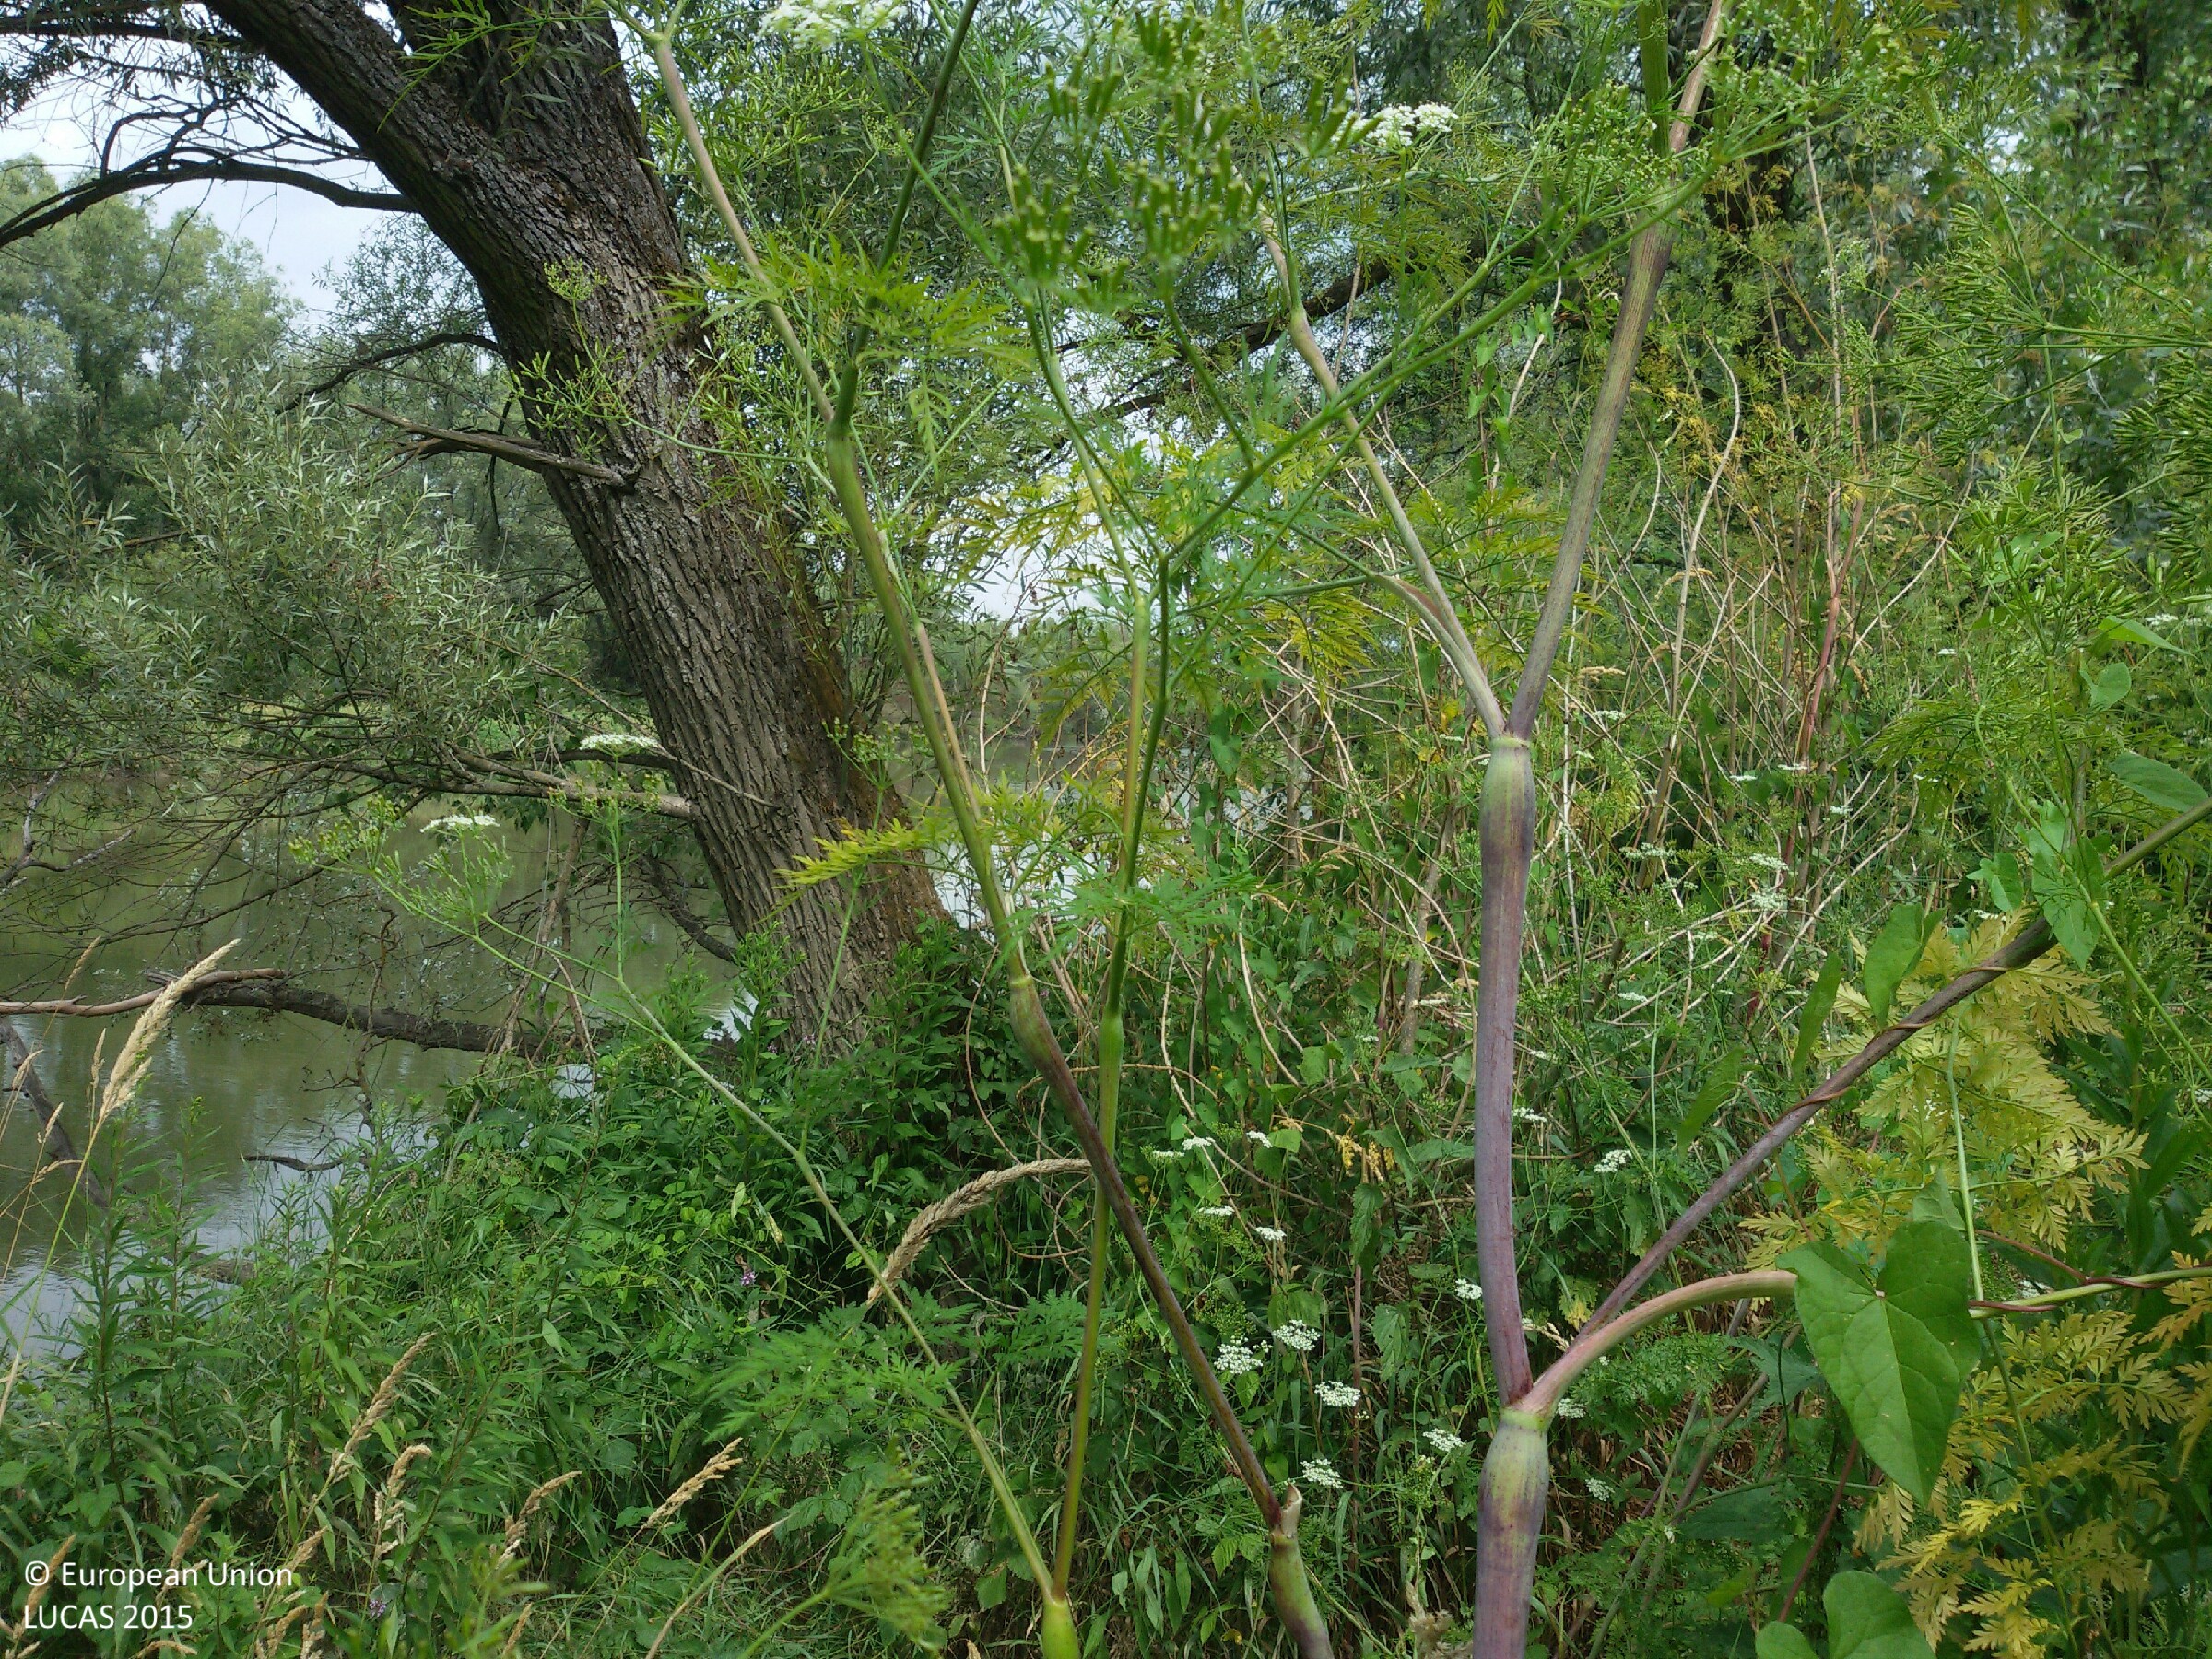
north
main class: Woodland
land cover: Broadleaved woodland
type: hemiboreal forest and nemoral coniferous forest and mixed broadleaved-coniferous forest
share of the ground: > 75 %
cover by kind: broadleaved forest trees 100 %
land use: Semi-natural and natural areas not in use
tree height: > 5 m
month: July
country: PL
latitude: 51.2219
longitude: 21.8109
